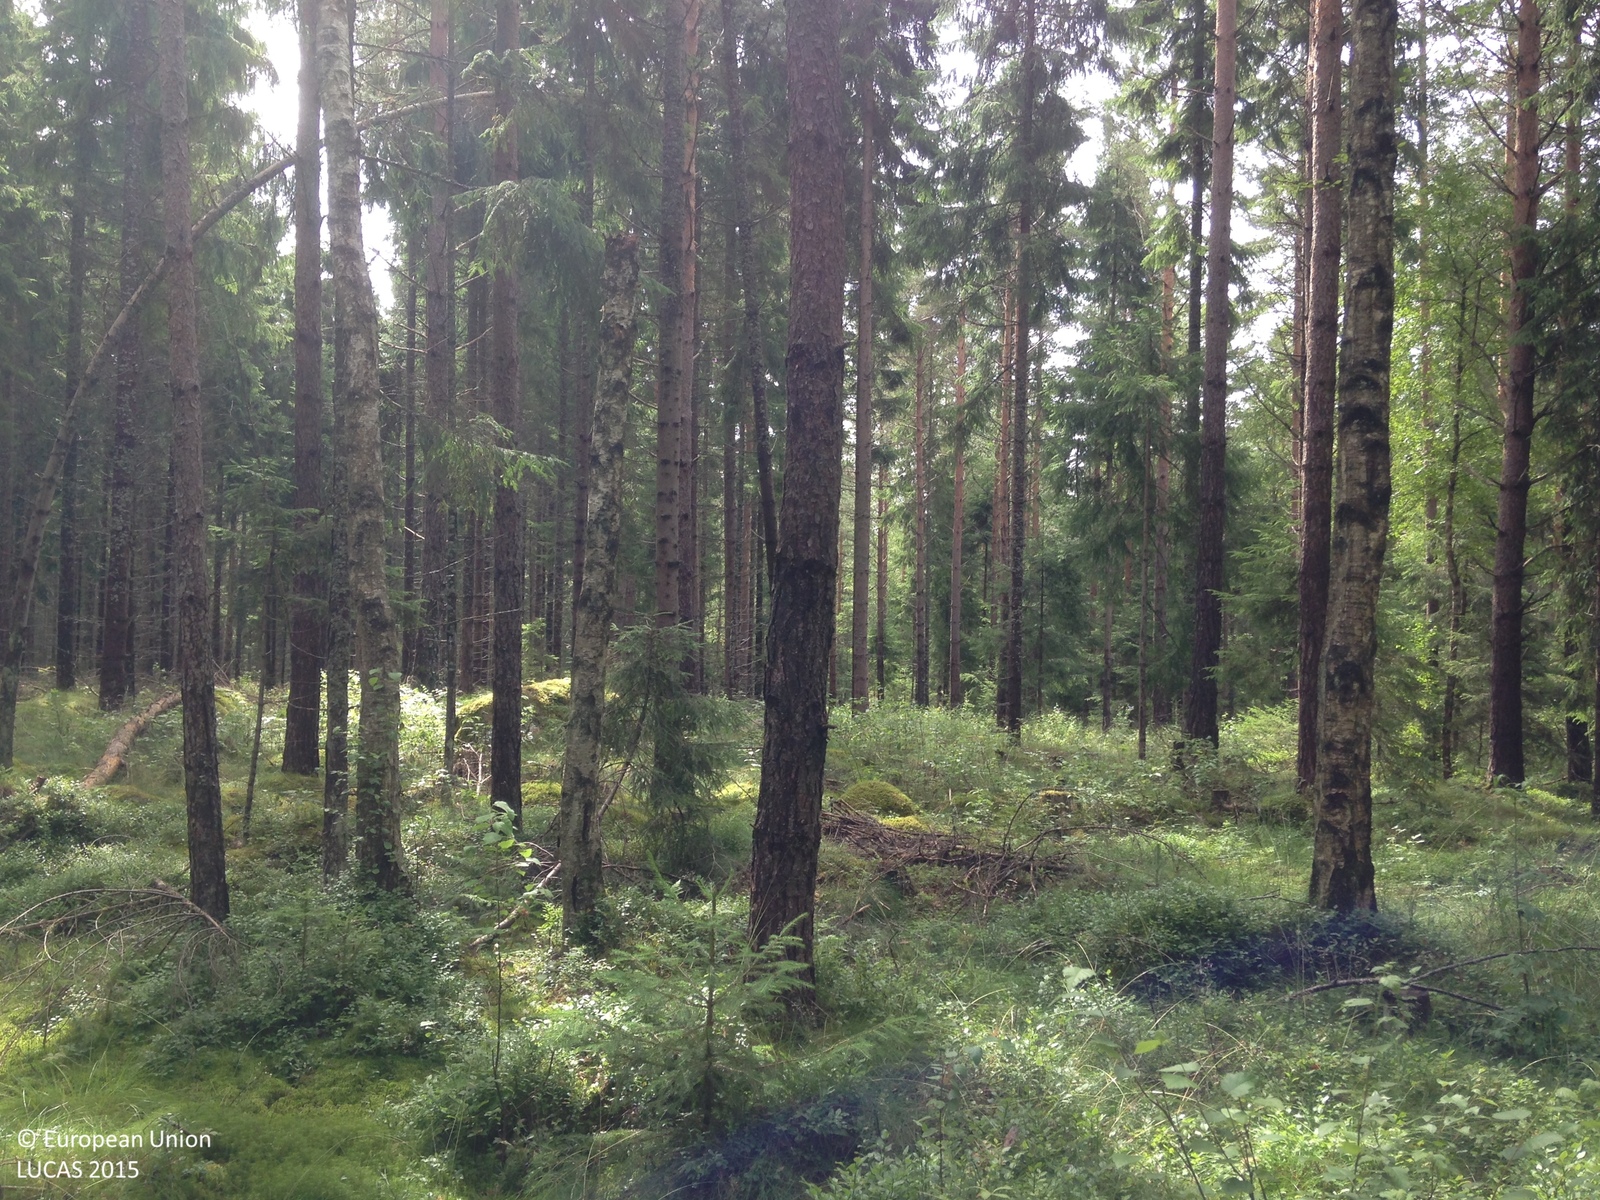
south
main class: Woodland
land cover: Other coniferous woodland
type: boreal forest
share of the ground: 25 - 50 %
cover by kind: coniferous forest trees 40 %, herbaceous plants 35 %, lichens and mosses 20 %, broadleaved forest trees 5 %
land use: Forestry
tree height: > 5 m
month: July
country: SE
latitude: 58.9946
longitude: 14.3957
